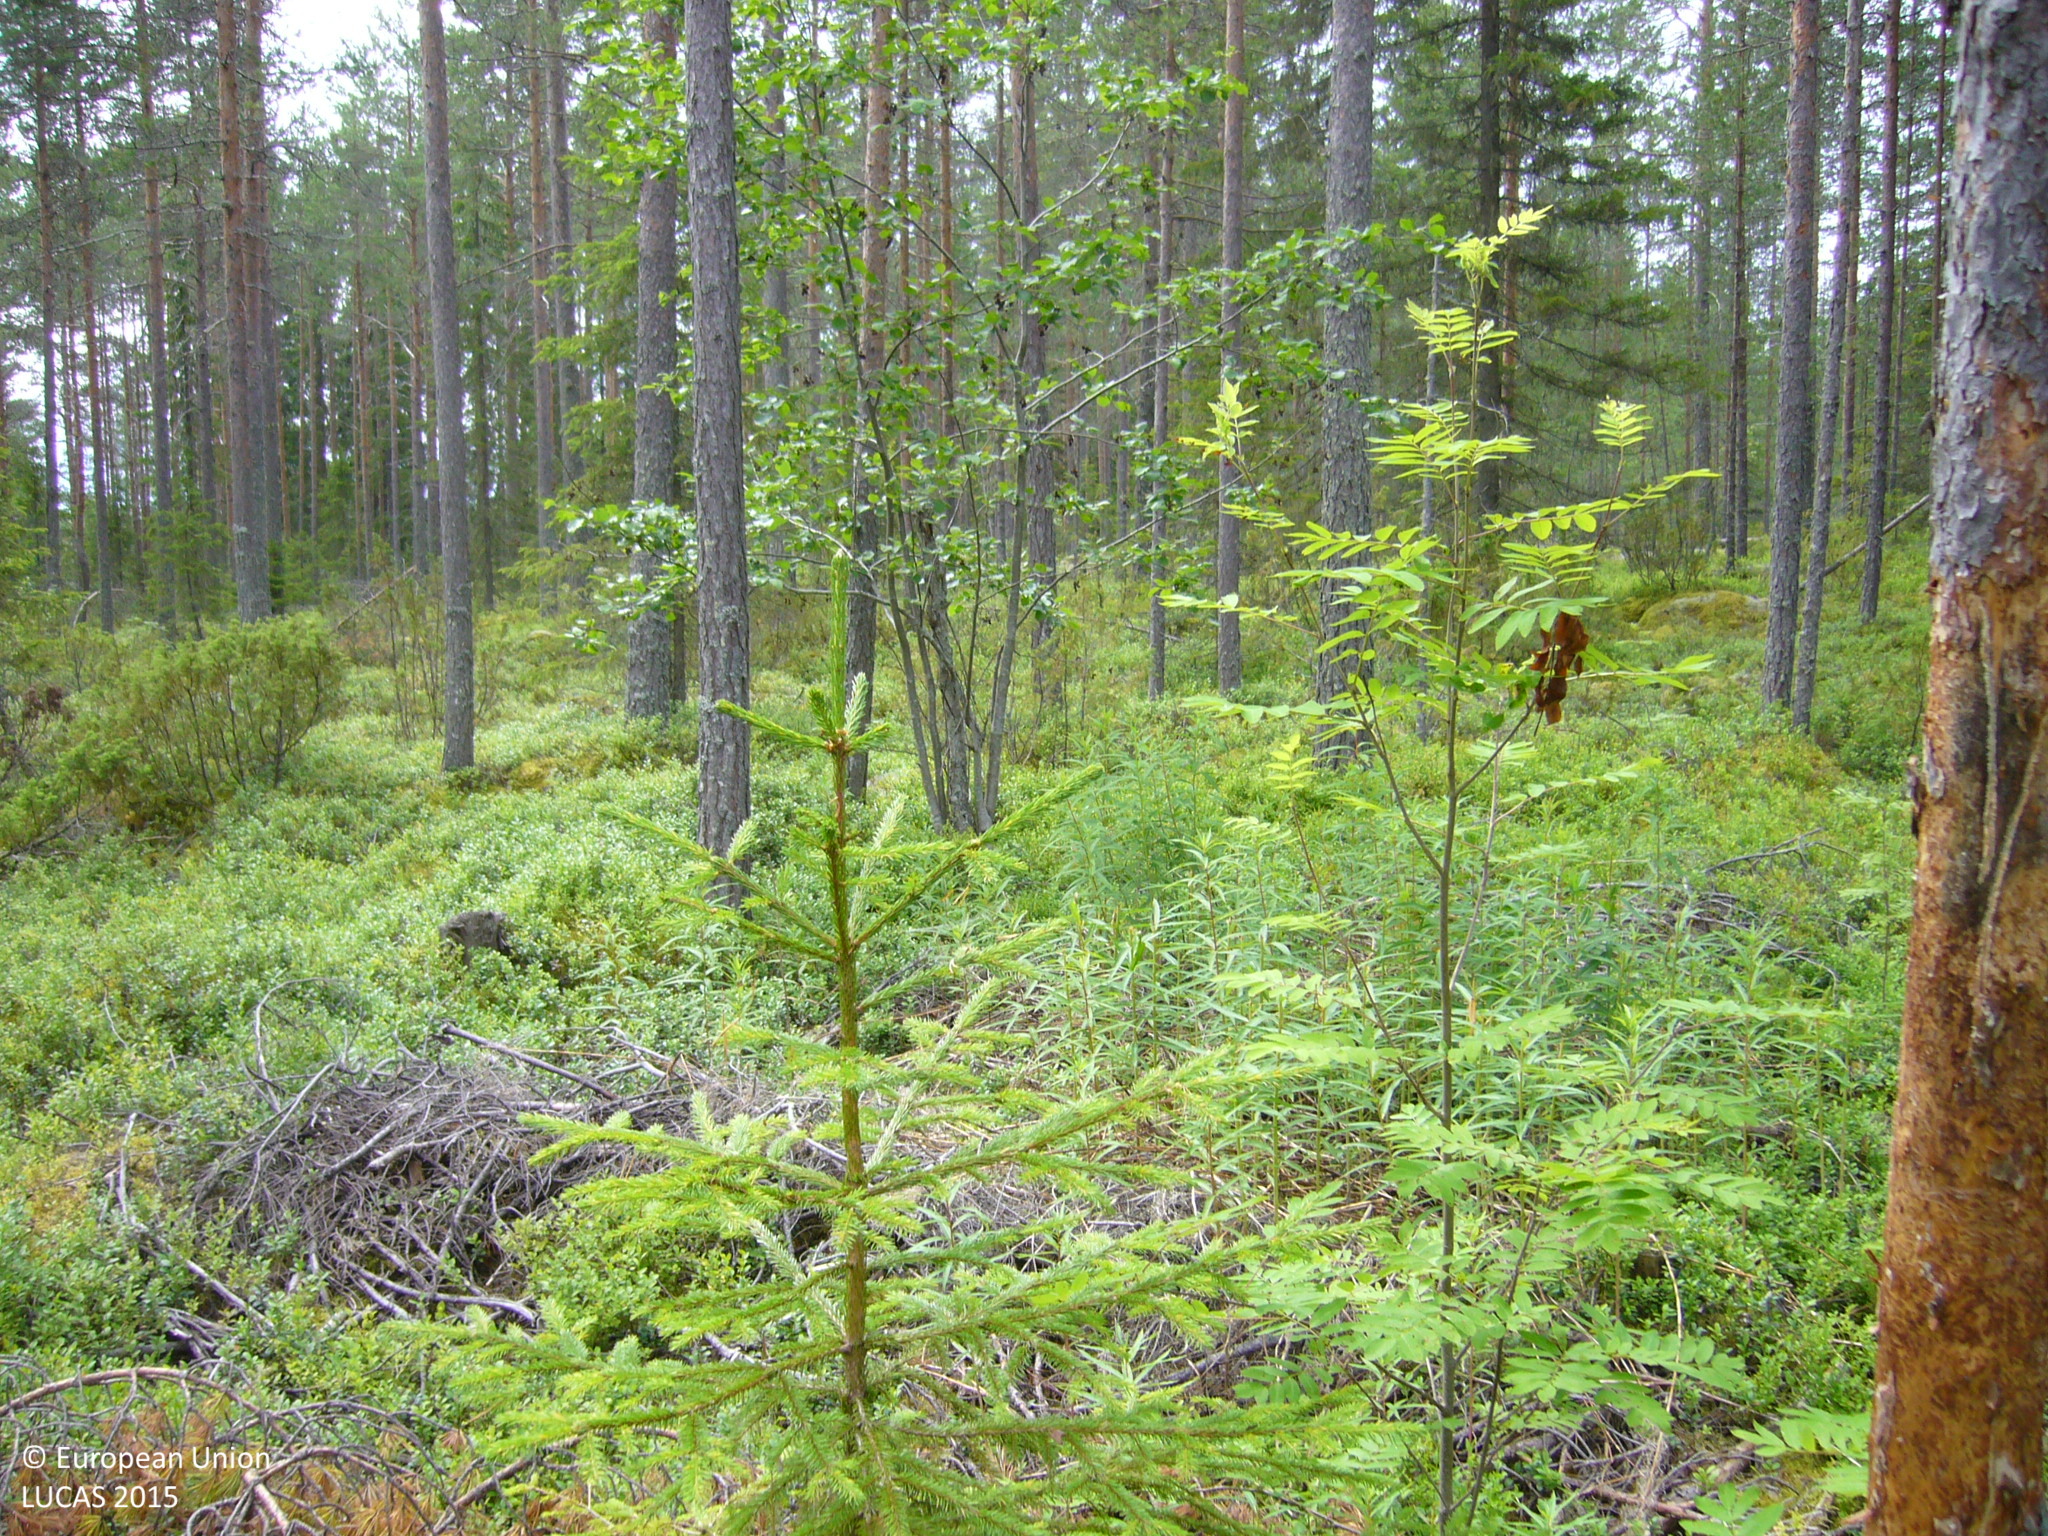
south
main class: Woodland
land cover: Pine dominated coniferous woodland
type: boreal forest
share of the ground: 50 - 75 %
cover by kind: coniferous forest trees 60 %, shrubs 30 %, lichens and mosses 10 %
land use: Forestry
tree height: > 5 m
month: July
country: FI
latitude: 63.8982
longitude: 25.7692
